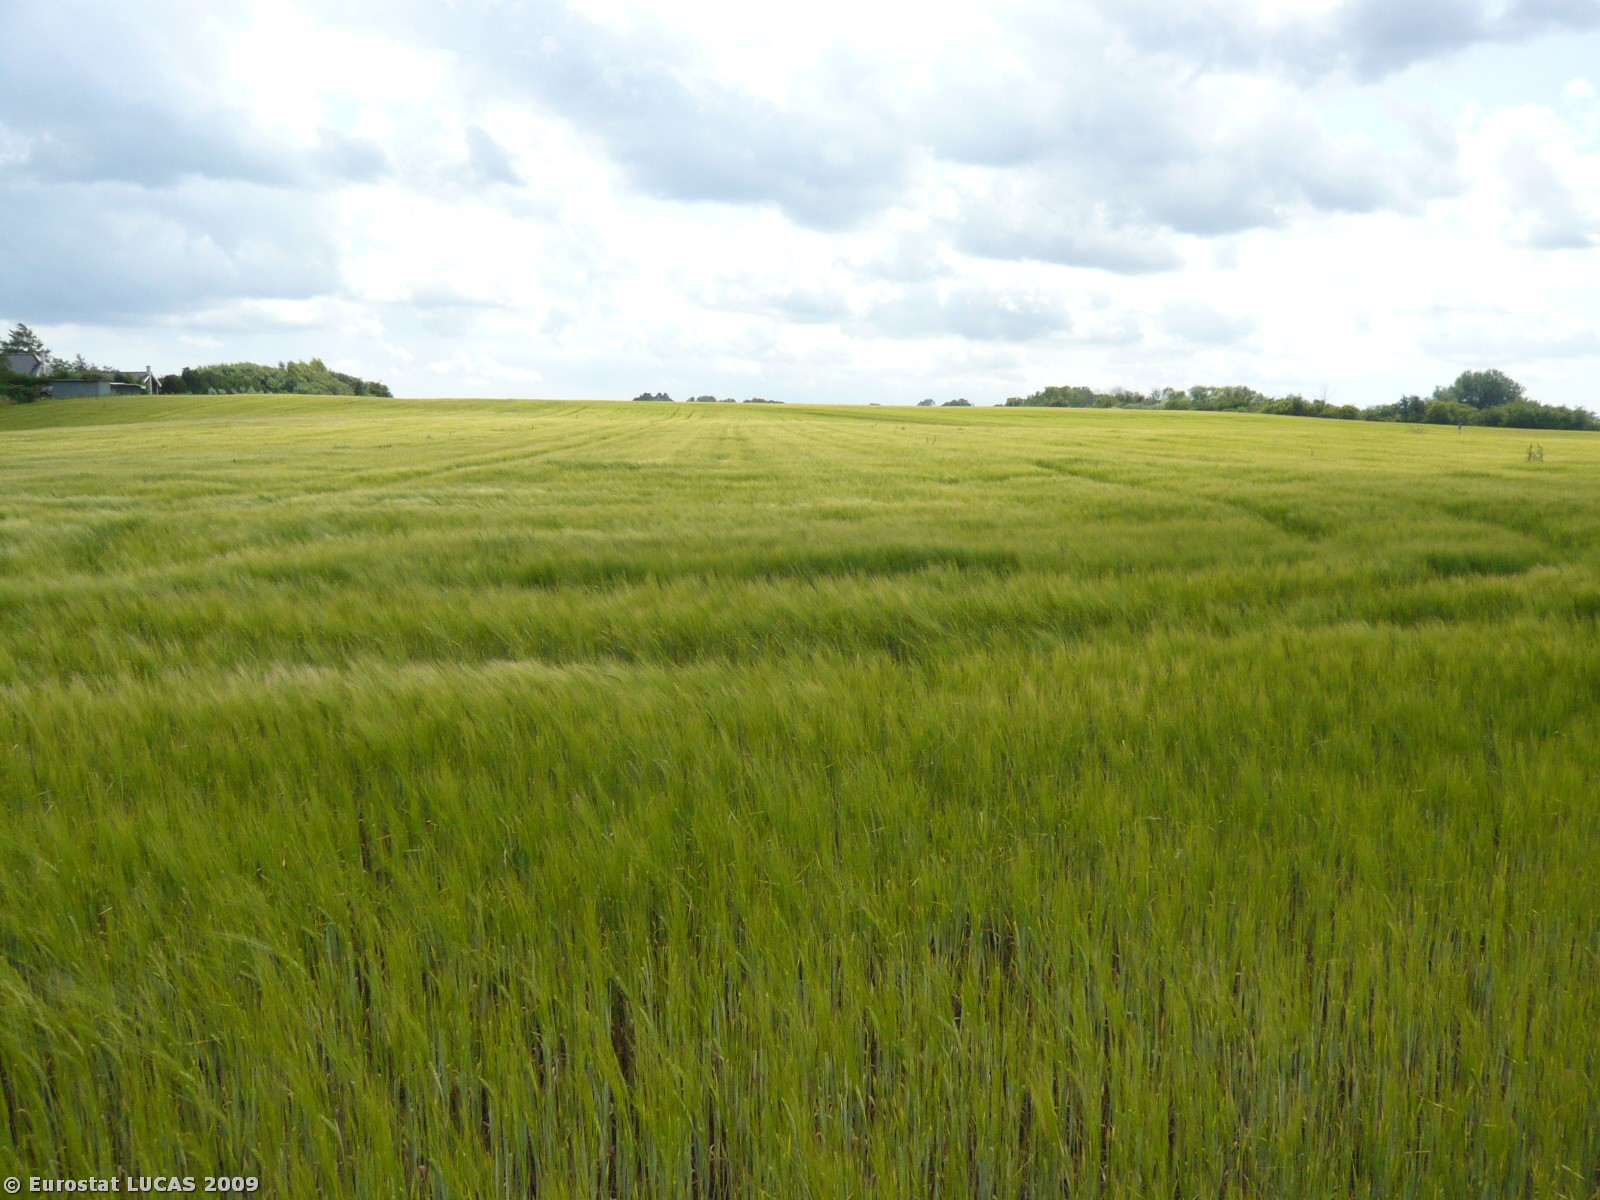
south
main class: Cropland
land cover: Barley
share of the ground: > 75 %
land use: Agriculture (excluding fallow land and kitchen gardens)
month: July
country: DK
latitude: 55.5677
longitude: 11.5051
